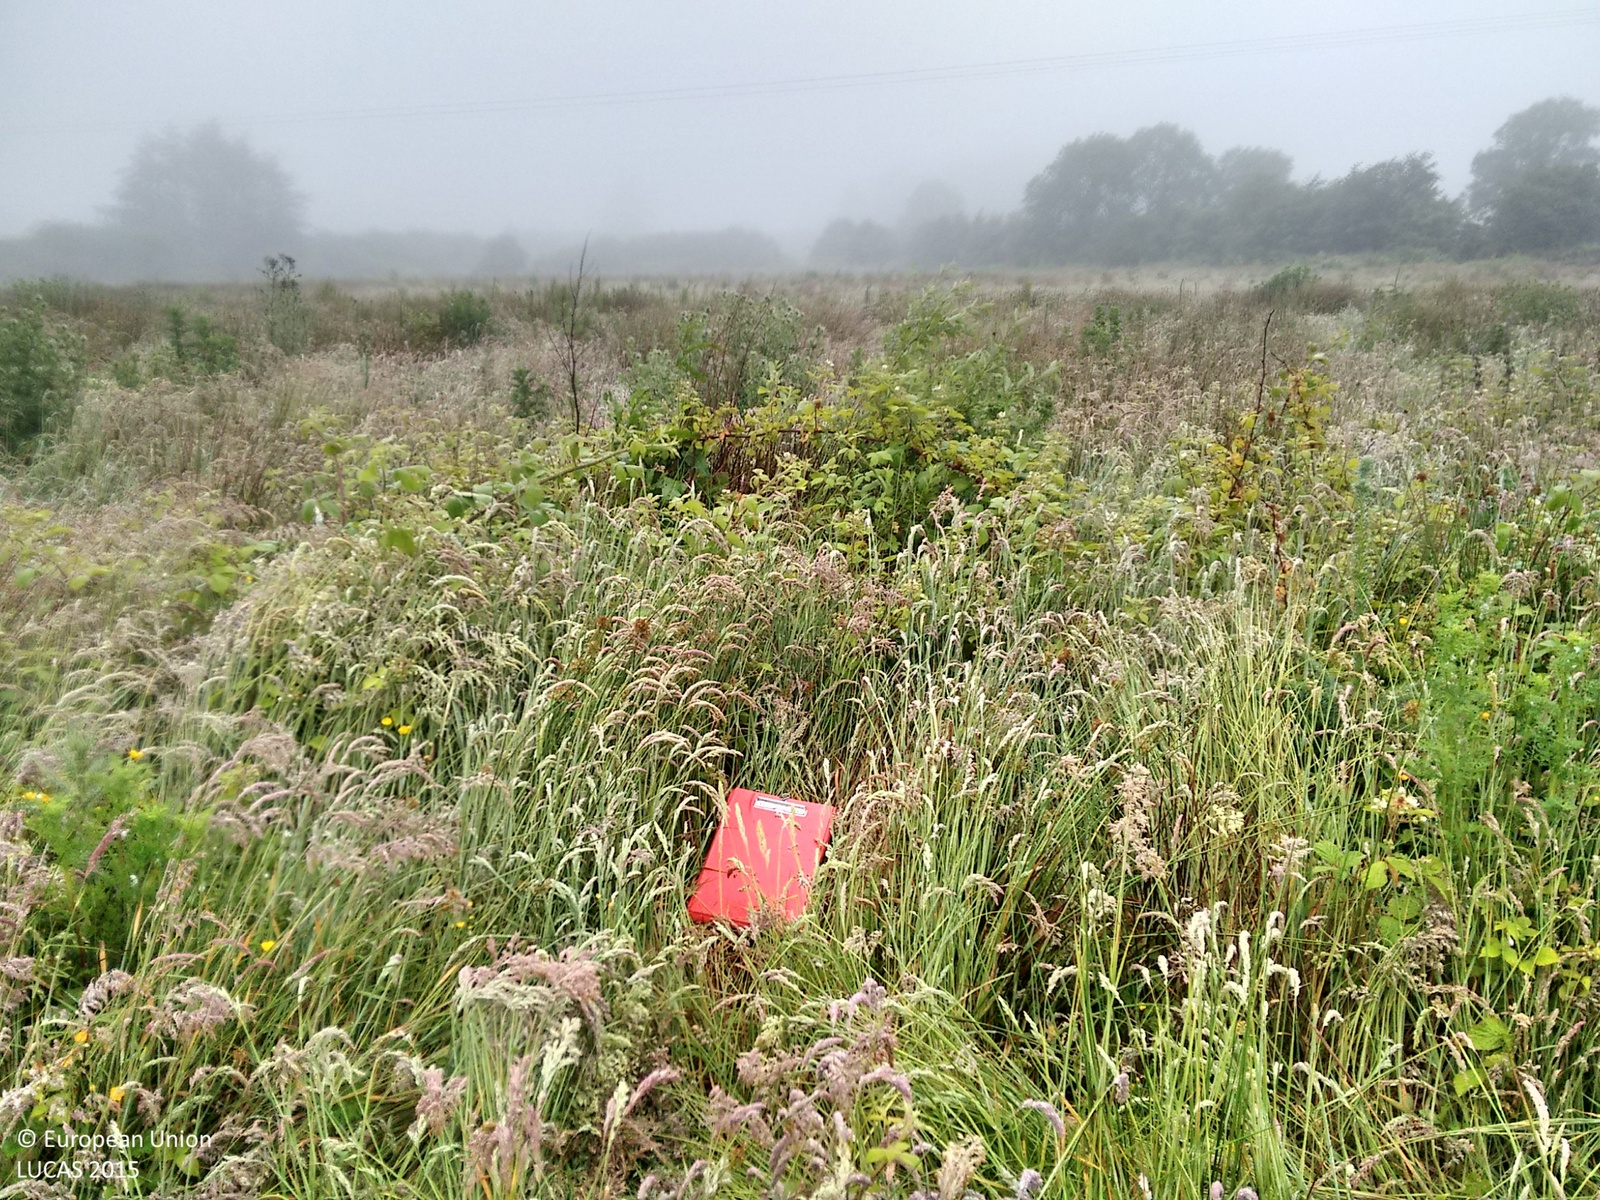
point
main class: Grassland
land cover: Spontaneously vegetated surfaces
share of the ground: > 75 %
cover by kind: herbaceous plants 95 %, shrubs 5 %
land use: Semi-natural and natural areas not in use
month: June
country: IE
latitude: 52.4039
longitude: -7.2757
